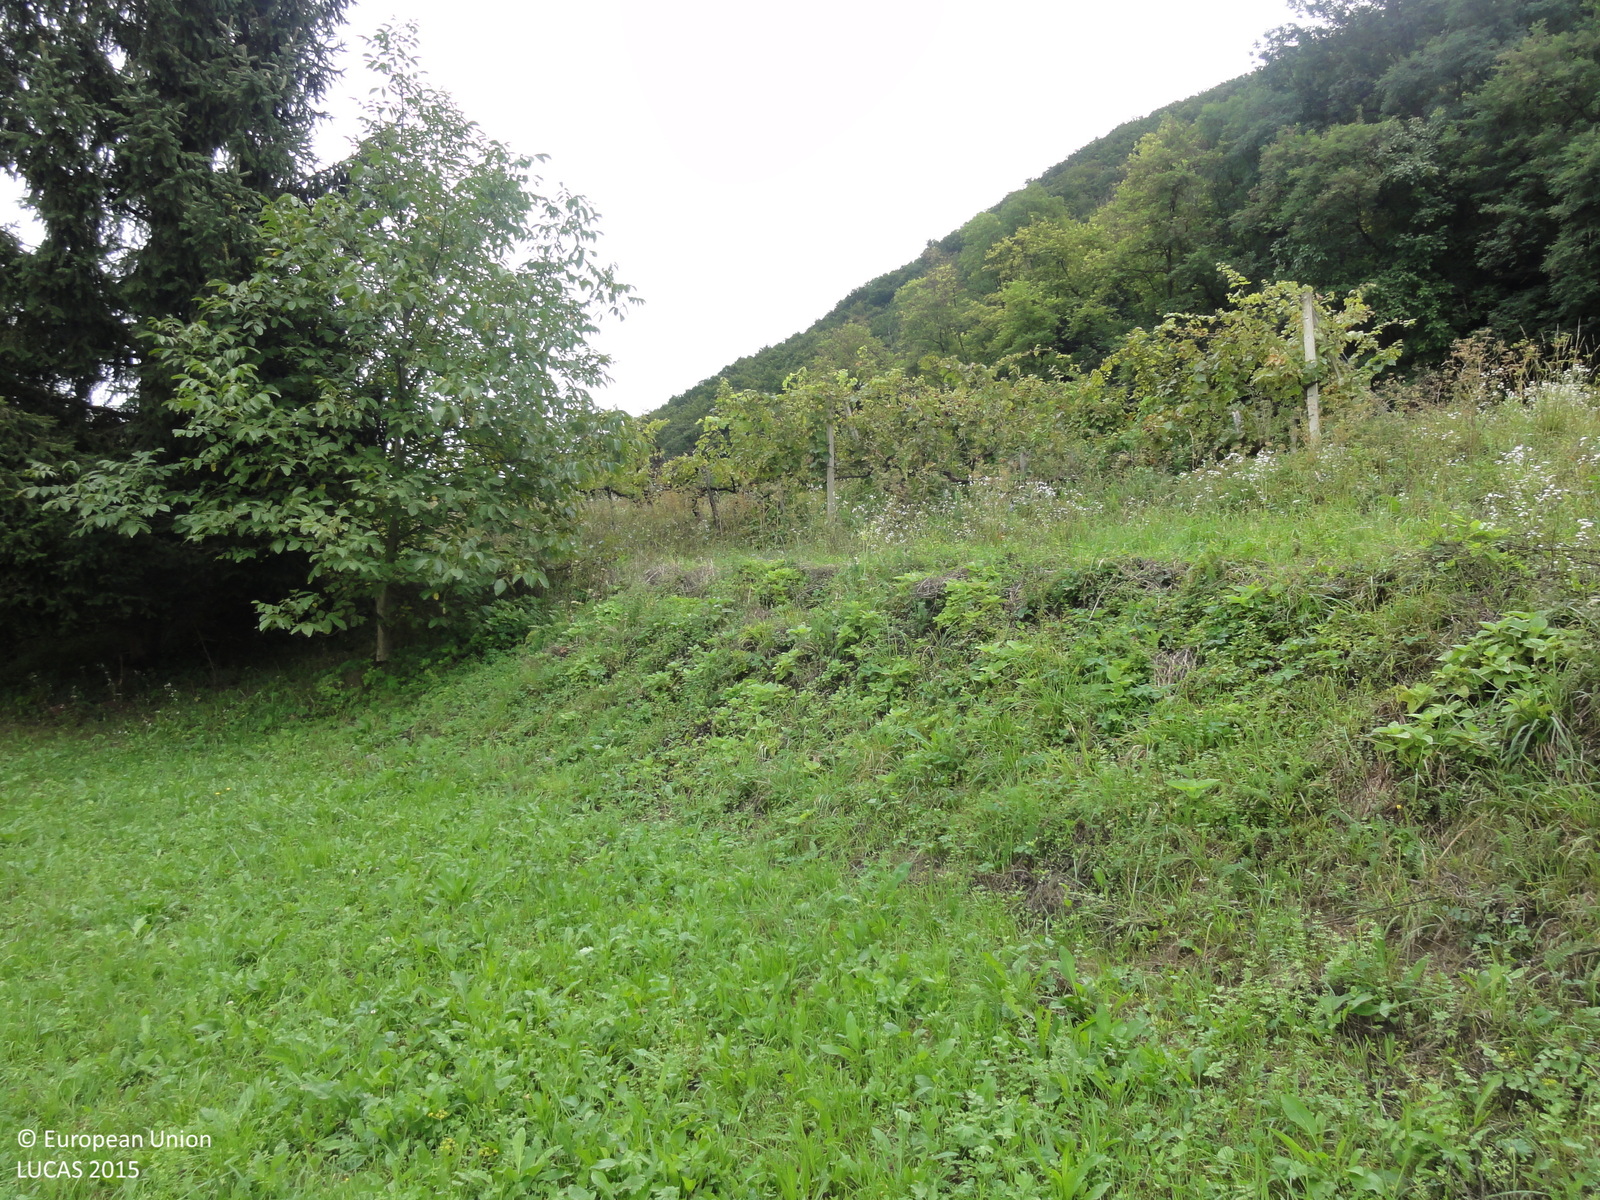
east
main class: Grassland
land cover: Grassland with sparse tree/shrub cover
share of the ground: > 75 %
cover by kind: herbaceous plants 90 %, coniferous forest trees 5 %, shrubs 5 %
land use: Agriculture (excluding fallow land and kitchen gardens)
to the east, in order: Grassland with sparse tree/shrub cover; Spruce dominated mixed woodland; Tracks; Vineyards; Grassland without tree/shrub cover; Fences; Grassland without tree/shrub cover; Broadleaved woodland; Fences; Broadleaved woodland
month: August
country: SI
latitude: 46.0563
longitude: 15.6722
